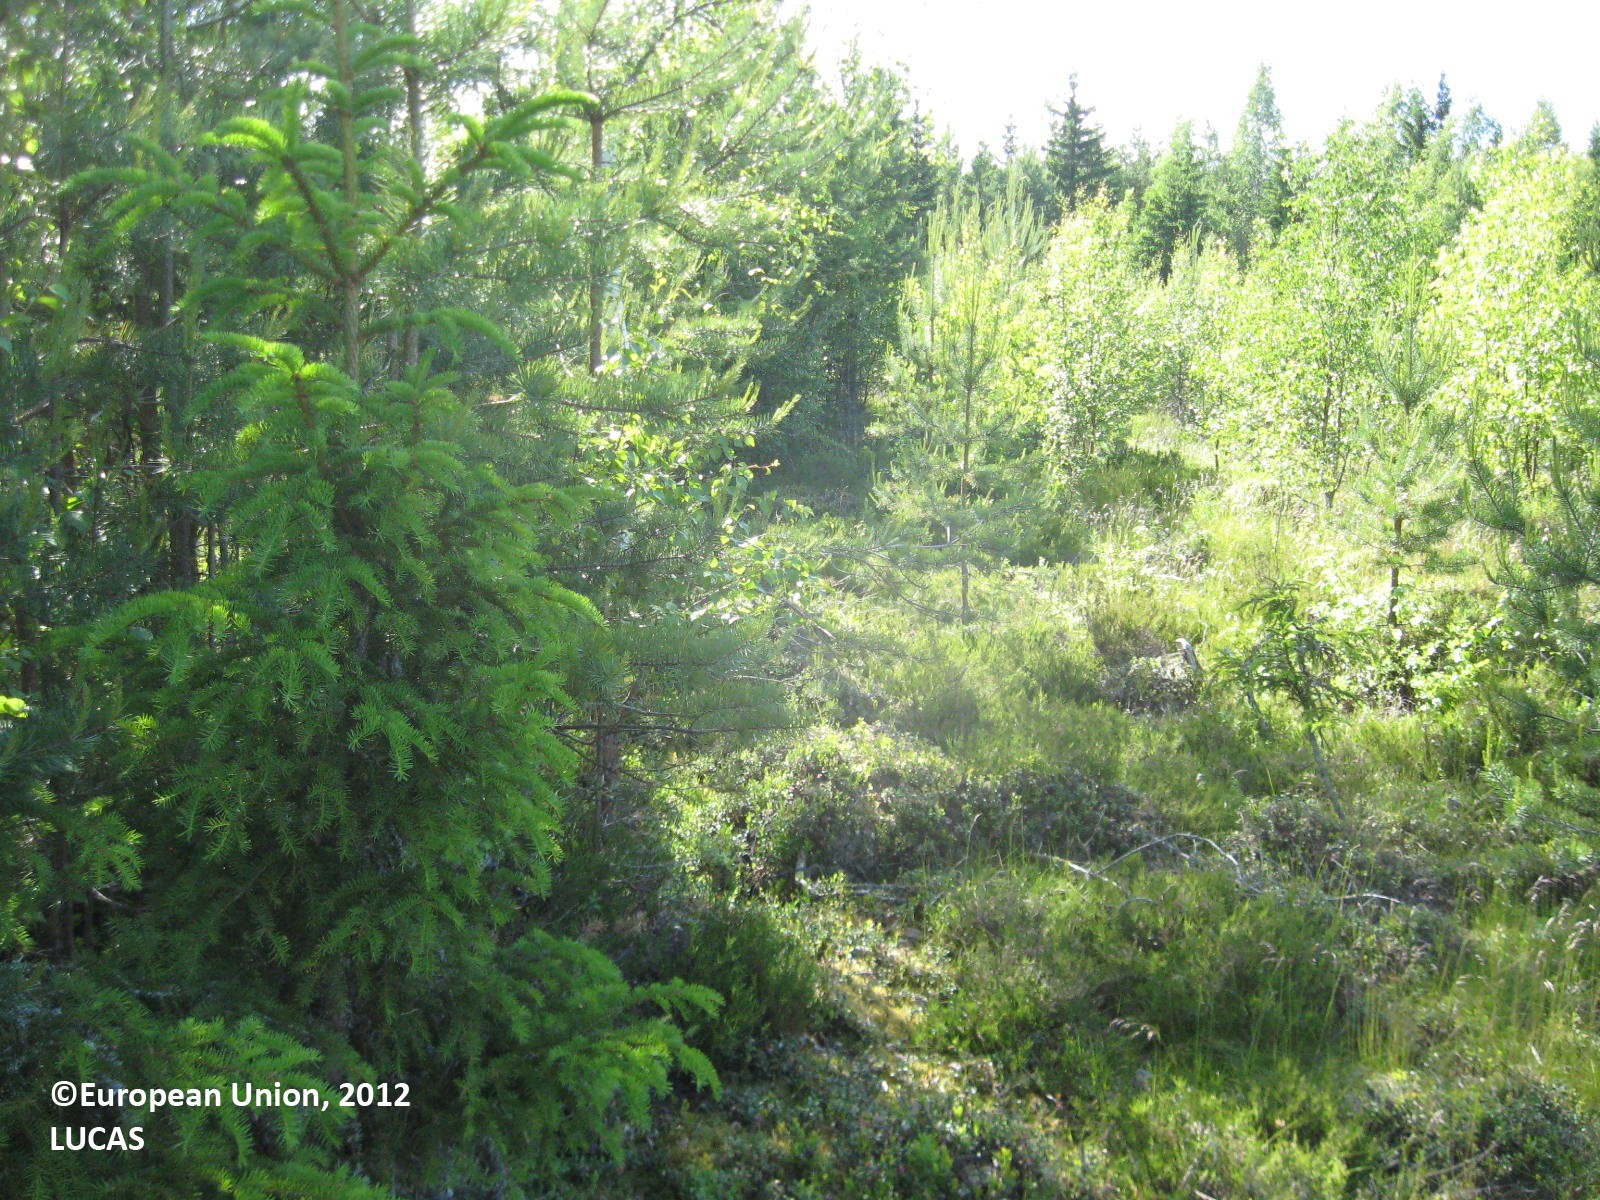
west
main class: Woodland
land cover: Other mixed woodland
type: boreal forest
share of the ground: > 75 %
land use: Forestry
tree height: < 5 m
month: June
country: FI
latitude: 62.6247
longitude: 21.7612
